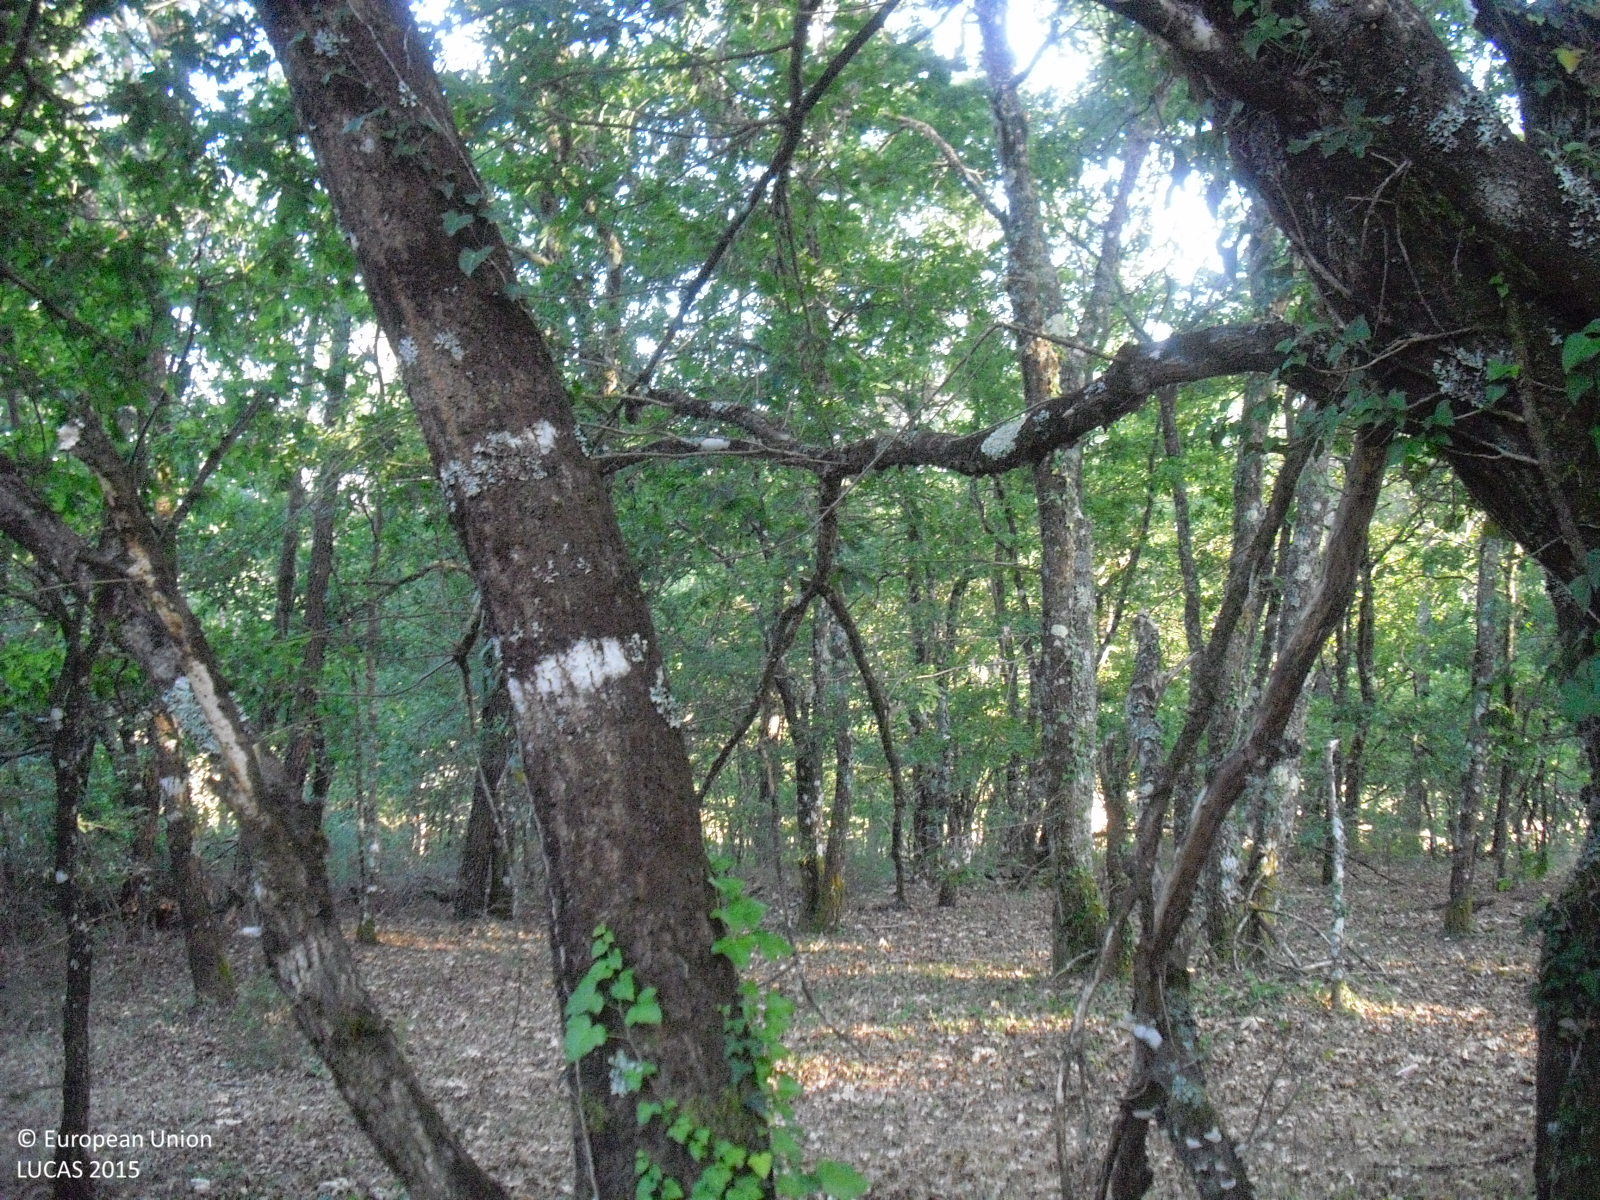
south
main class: Woodland
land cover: Pine dominated mixed woodland
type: hemiboreal forest and nemoral coniferous forest and mixed broadleaved-coniferous forest
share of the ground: > 75 %
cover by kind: coniferous forest trees 60 %, broadleaved forest trees 30 %, shrubs 10 %
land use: Forestry
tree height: > 5 m
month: July
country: ES
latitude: 42.6114
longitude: -7.4901
